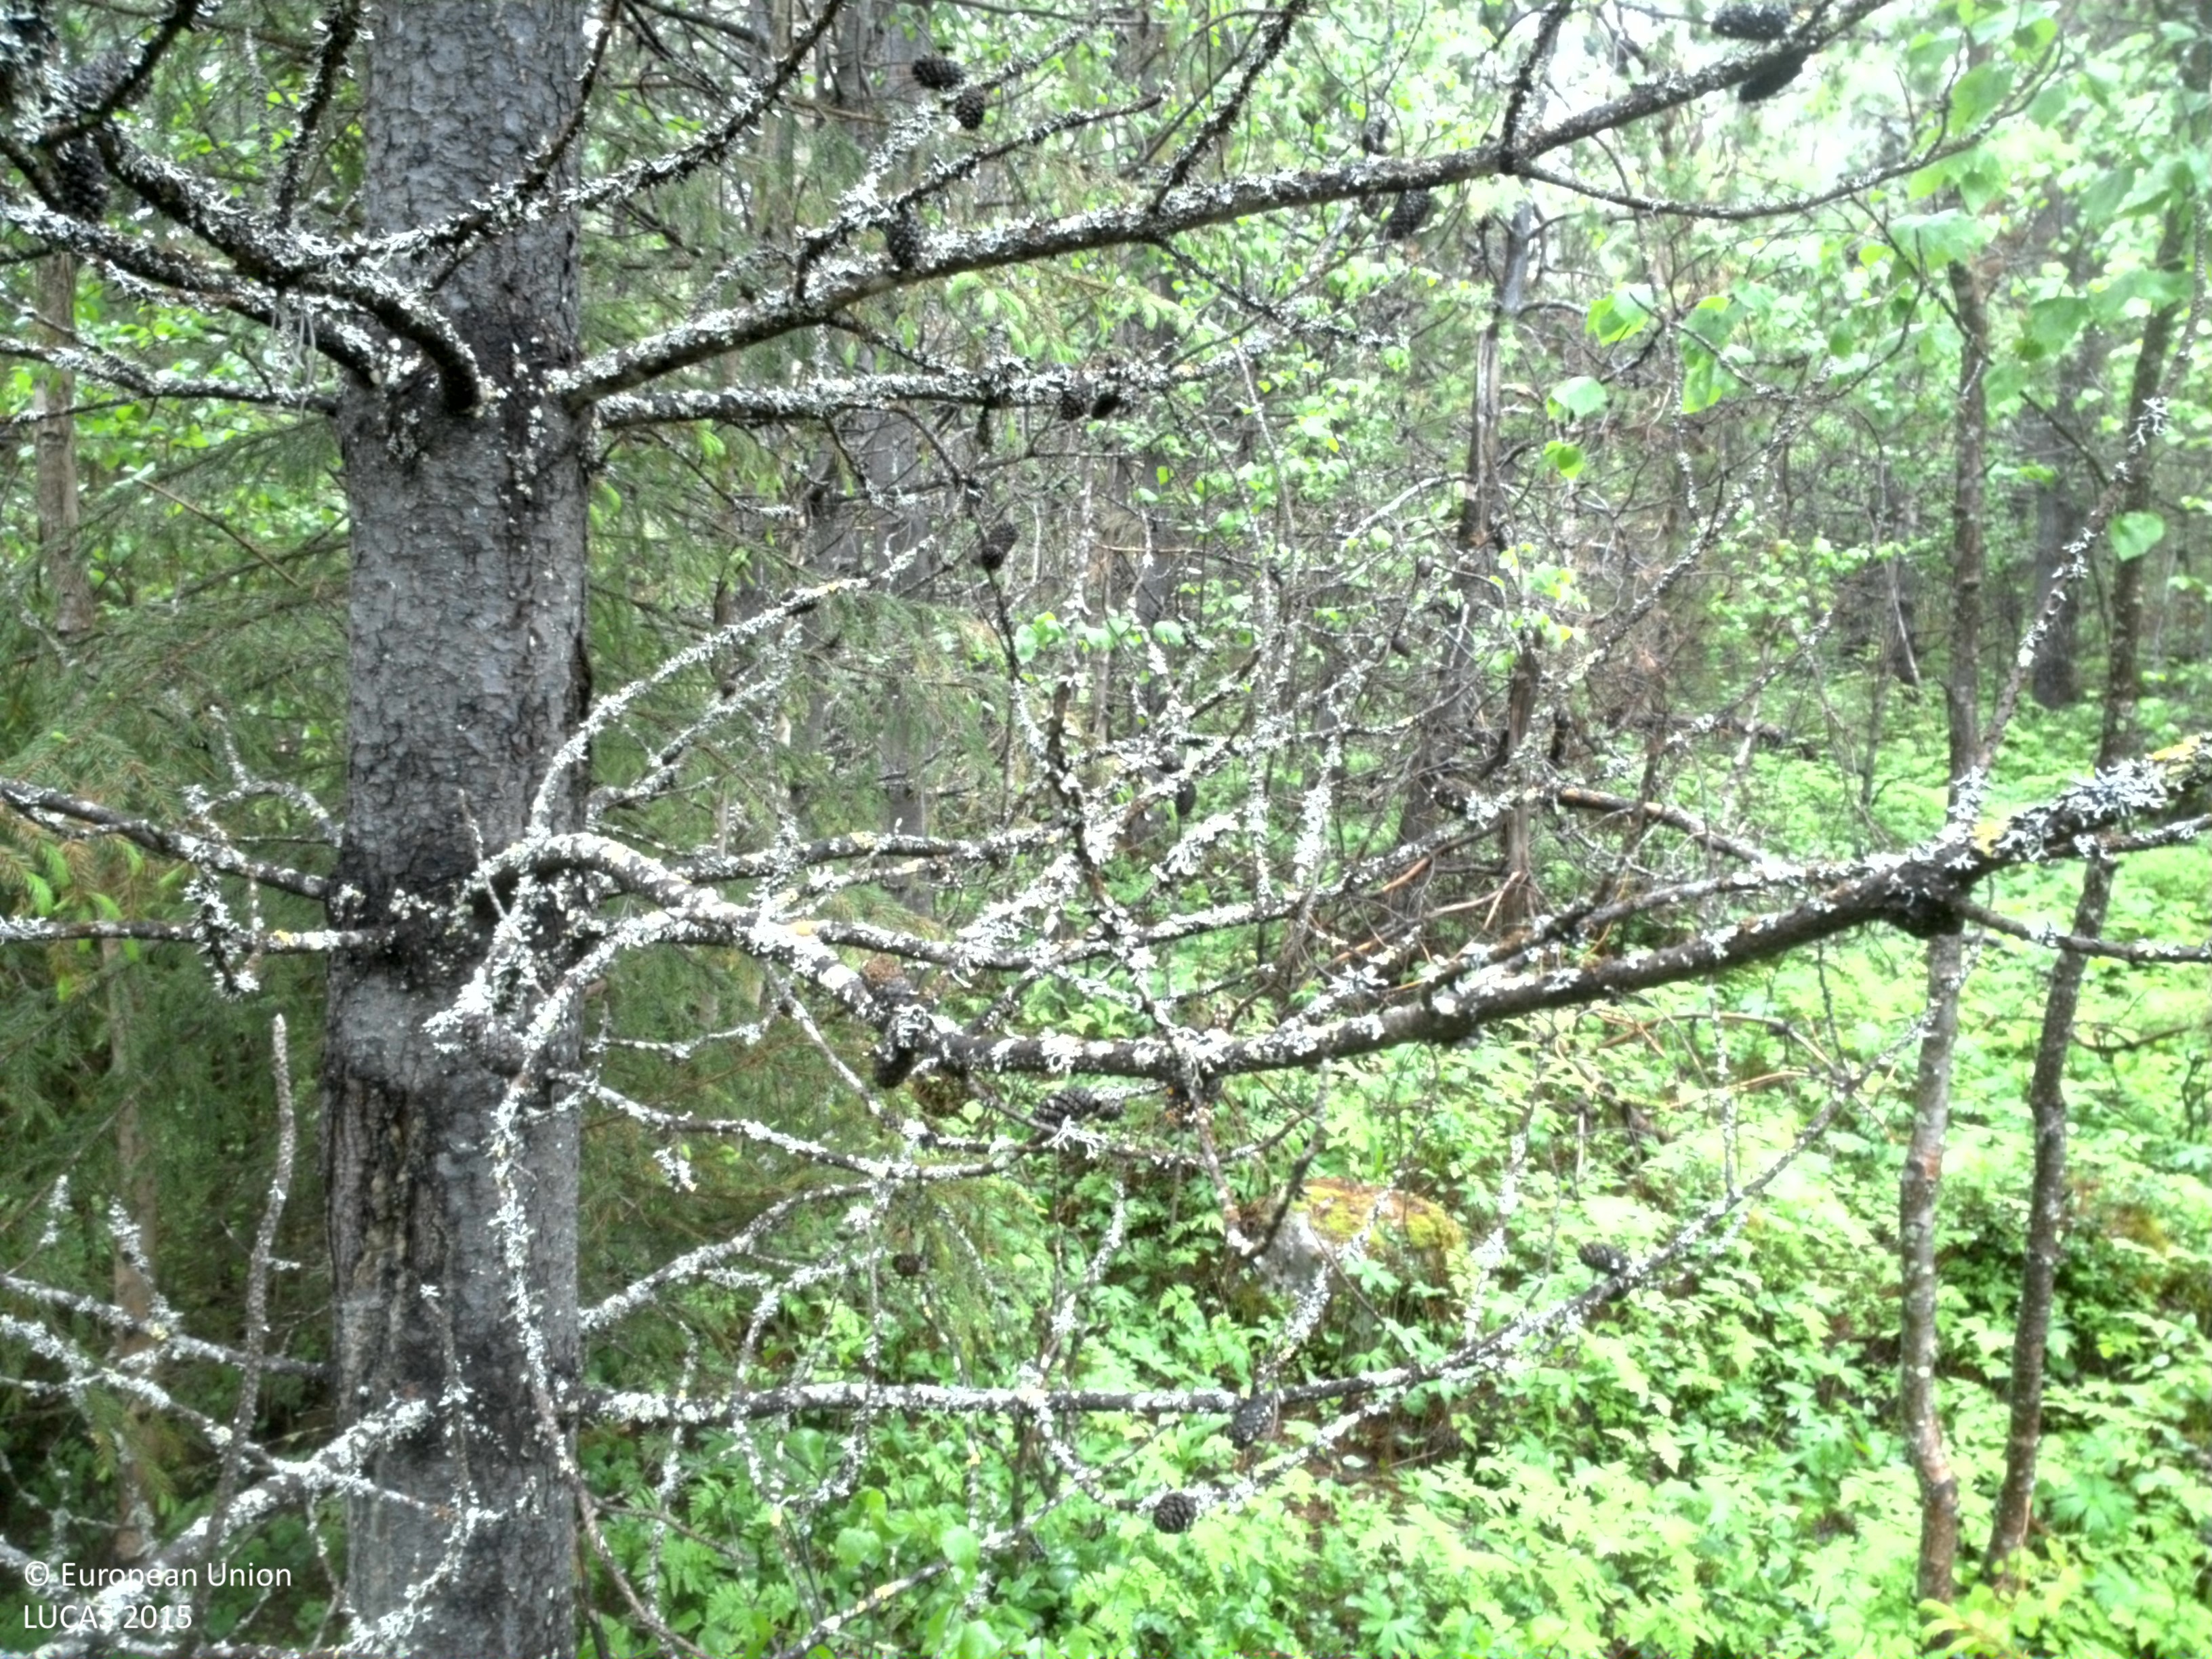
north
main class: Woodland
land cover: Pine dominated mixed woodland
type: exotic forest
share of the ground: > 75 %
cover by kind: coniferous forest trees 40 %, broadleaved forest trees 40 %, shrubs 10 %, herbaceous plants 10 %
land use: Forestry
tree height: > 5 m
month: June
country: SE
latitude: 66.5776
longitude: 22.8016
